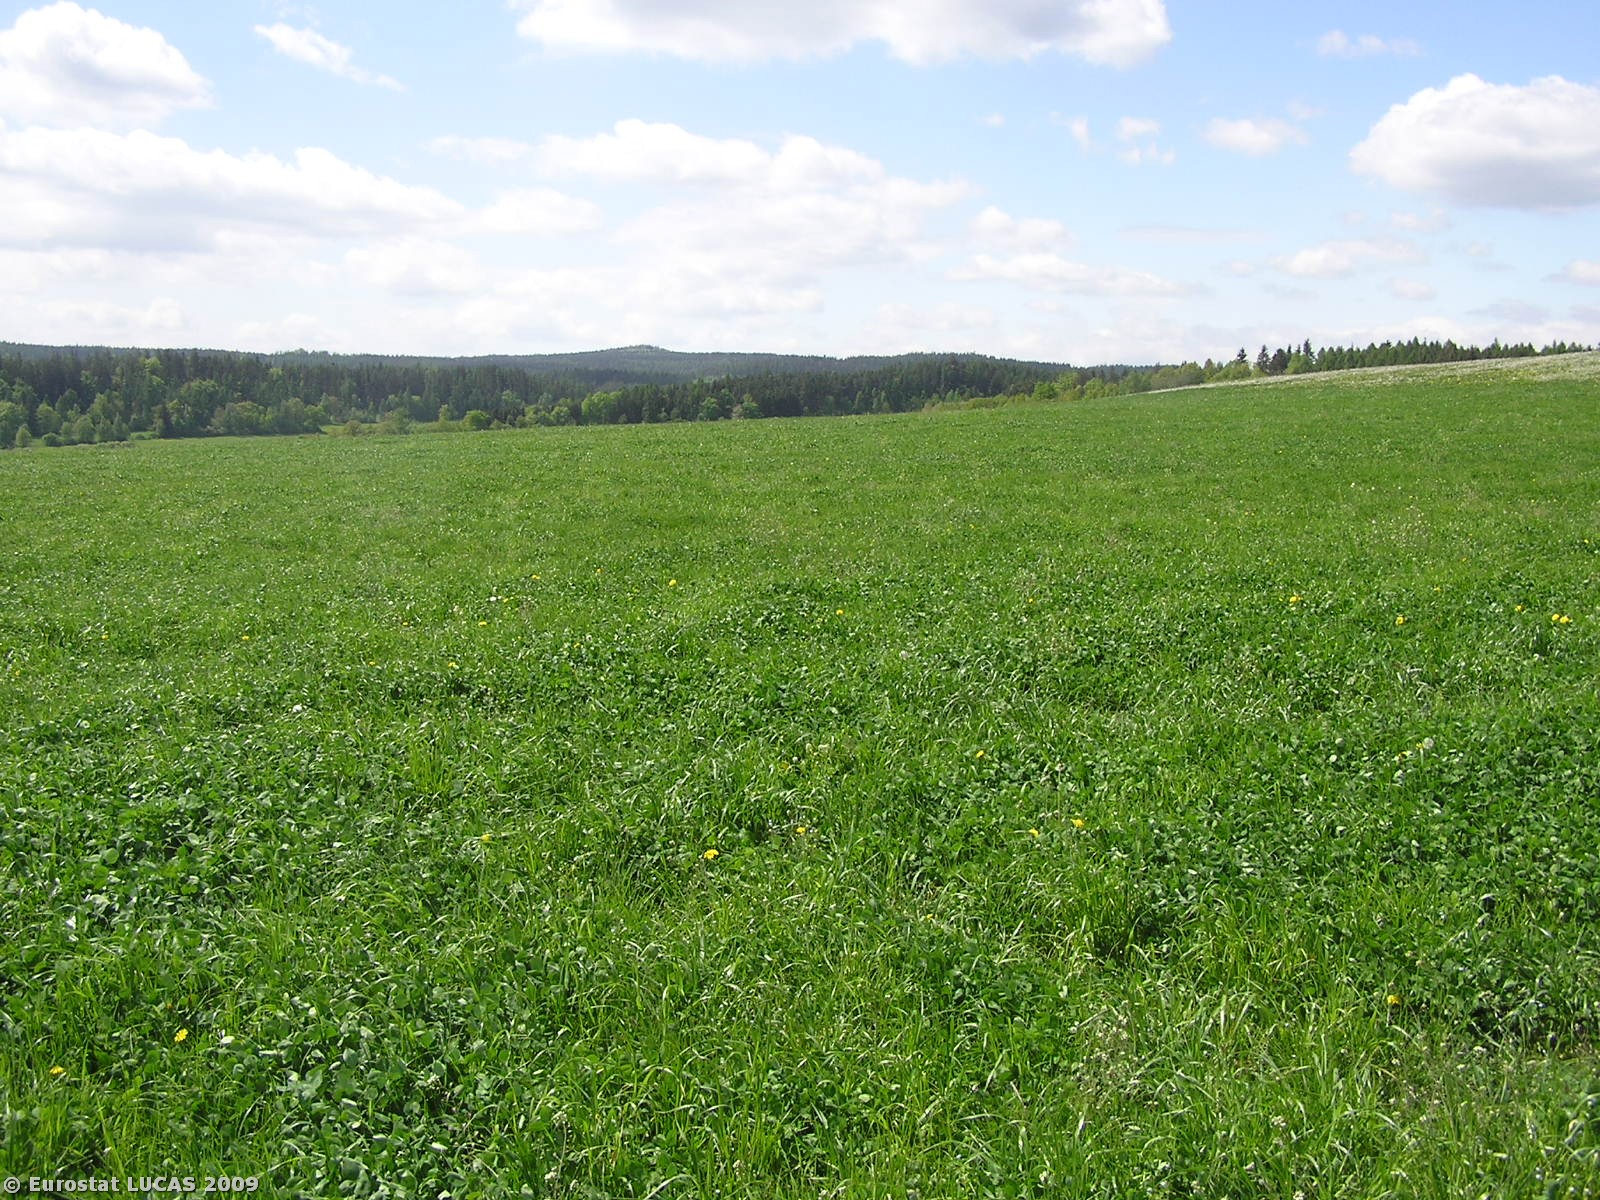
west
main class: Cropland
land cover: Clovers
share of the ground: > 75 %
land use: Agriculture (excluding fallow land and kitchen gardens)
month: May
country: CZ
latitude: 50.0194
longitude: 17.6195
